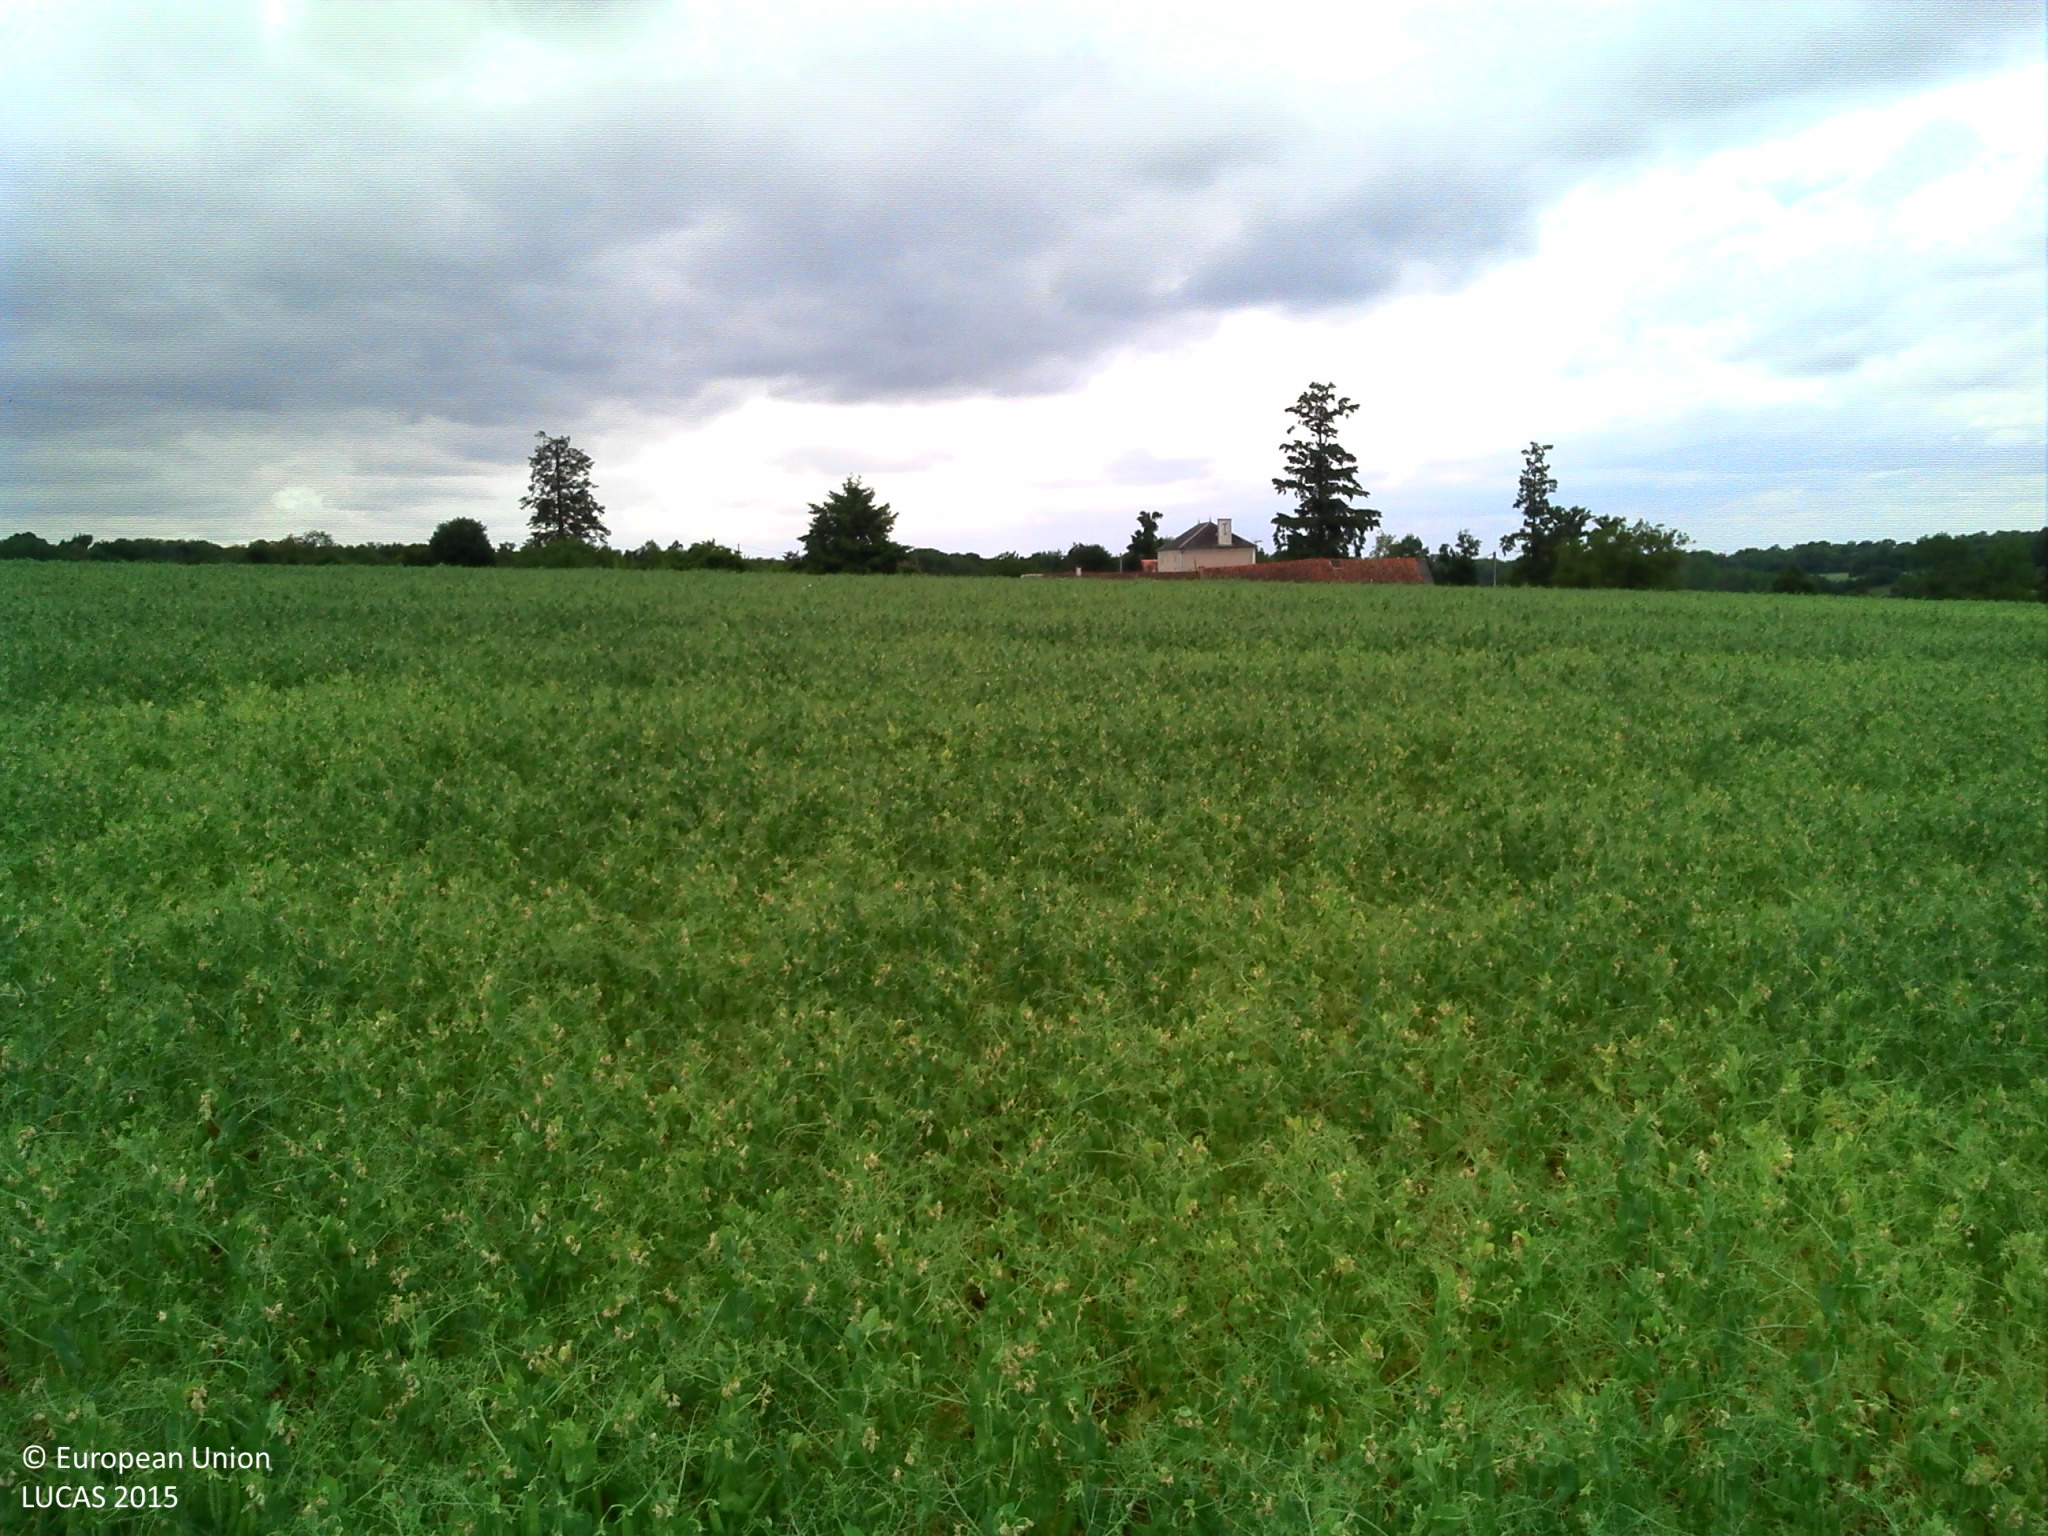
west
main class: Cropland
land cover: Dry pulses
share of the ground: > 75 %
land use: Agriculture (excluding fallow land and kitchen gardens)
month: June
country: FR
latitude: 46.0368
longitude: 0.3052
